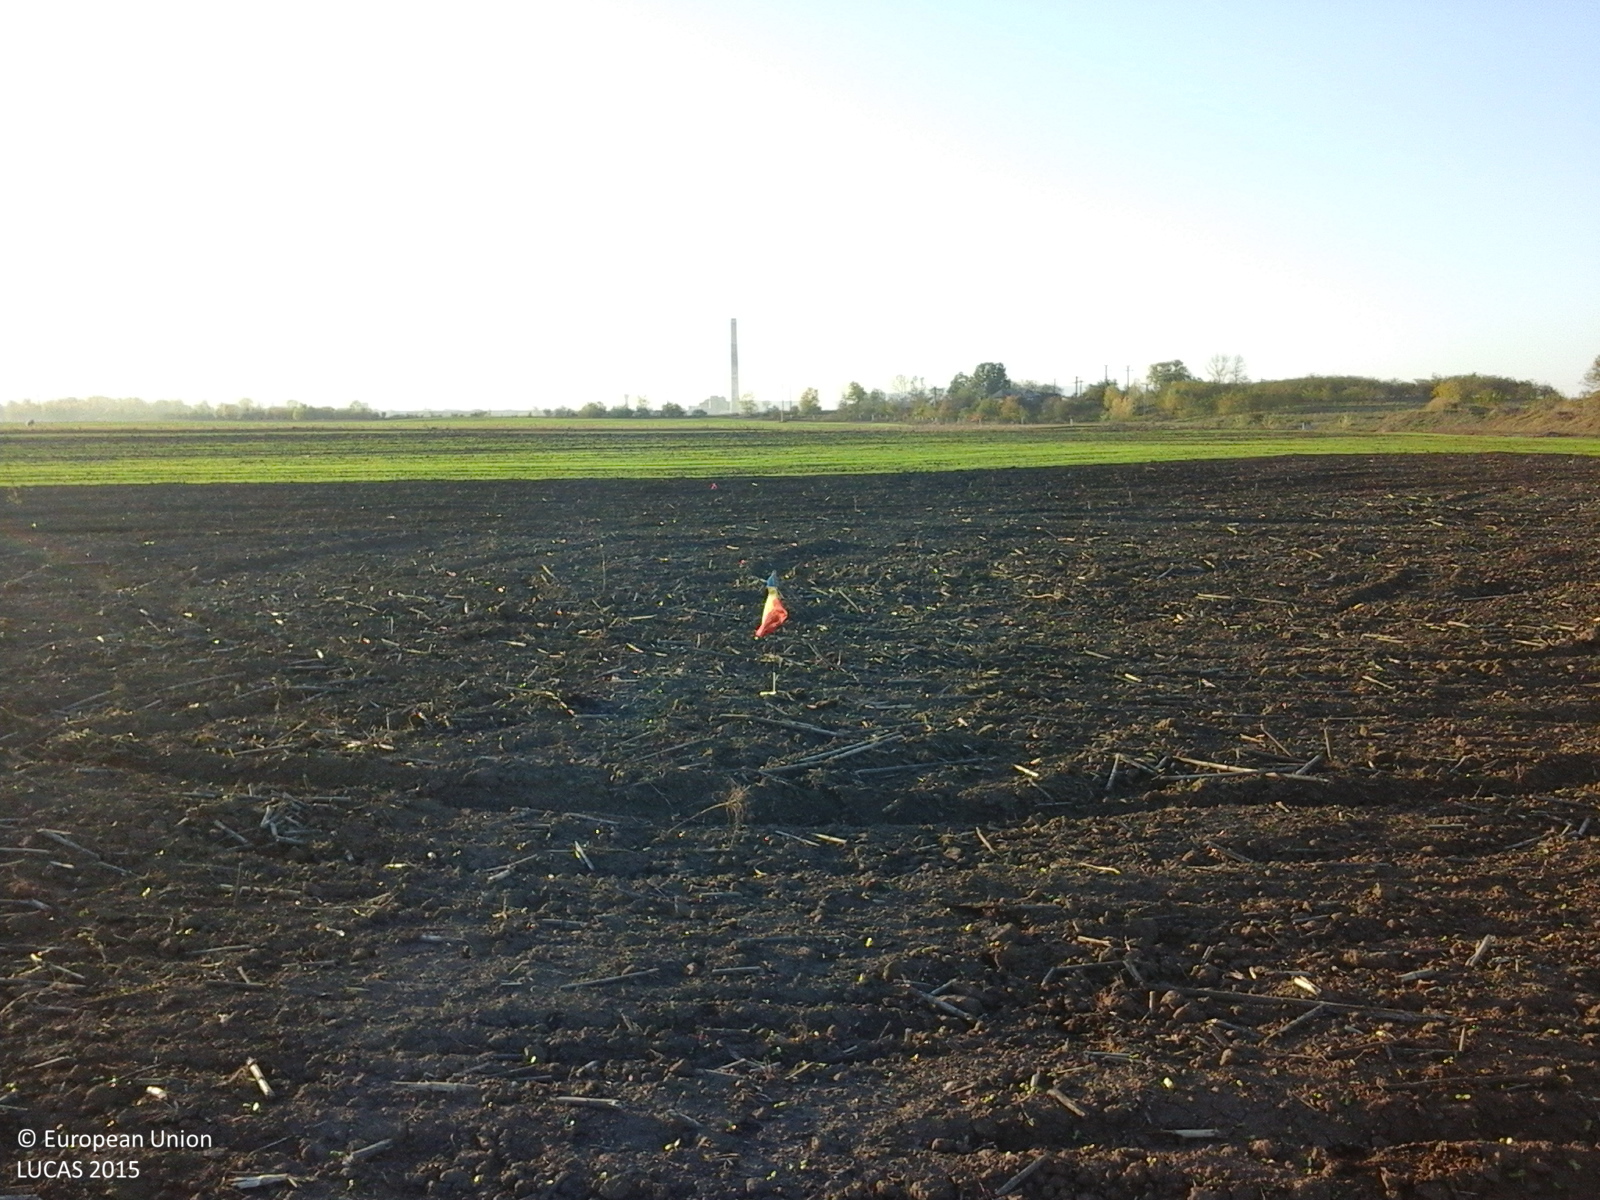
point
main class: Cropland
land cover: Sunflower
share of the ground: < 10 %
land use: Agriculture (excluding fallow land and kitchen gardens)
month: October
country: RO
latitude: 46.1014
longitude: 27.2134
